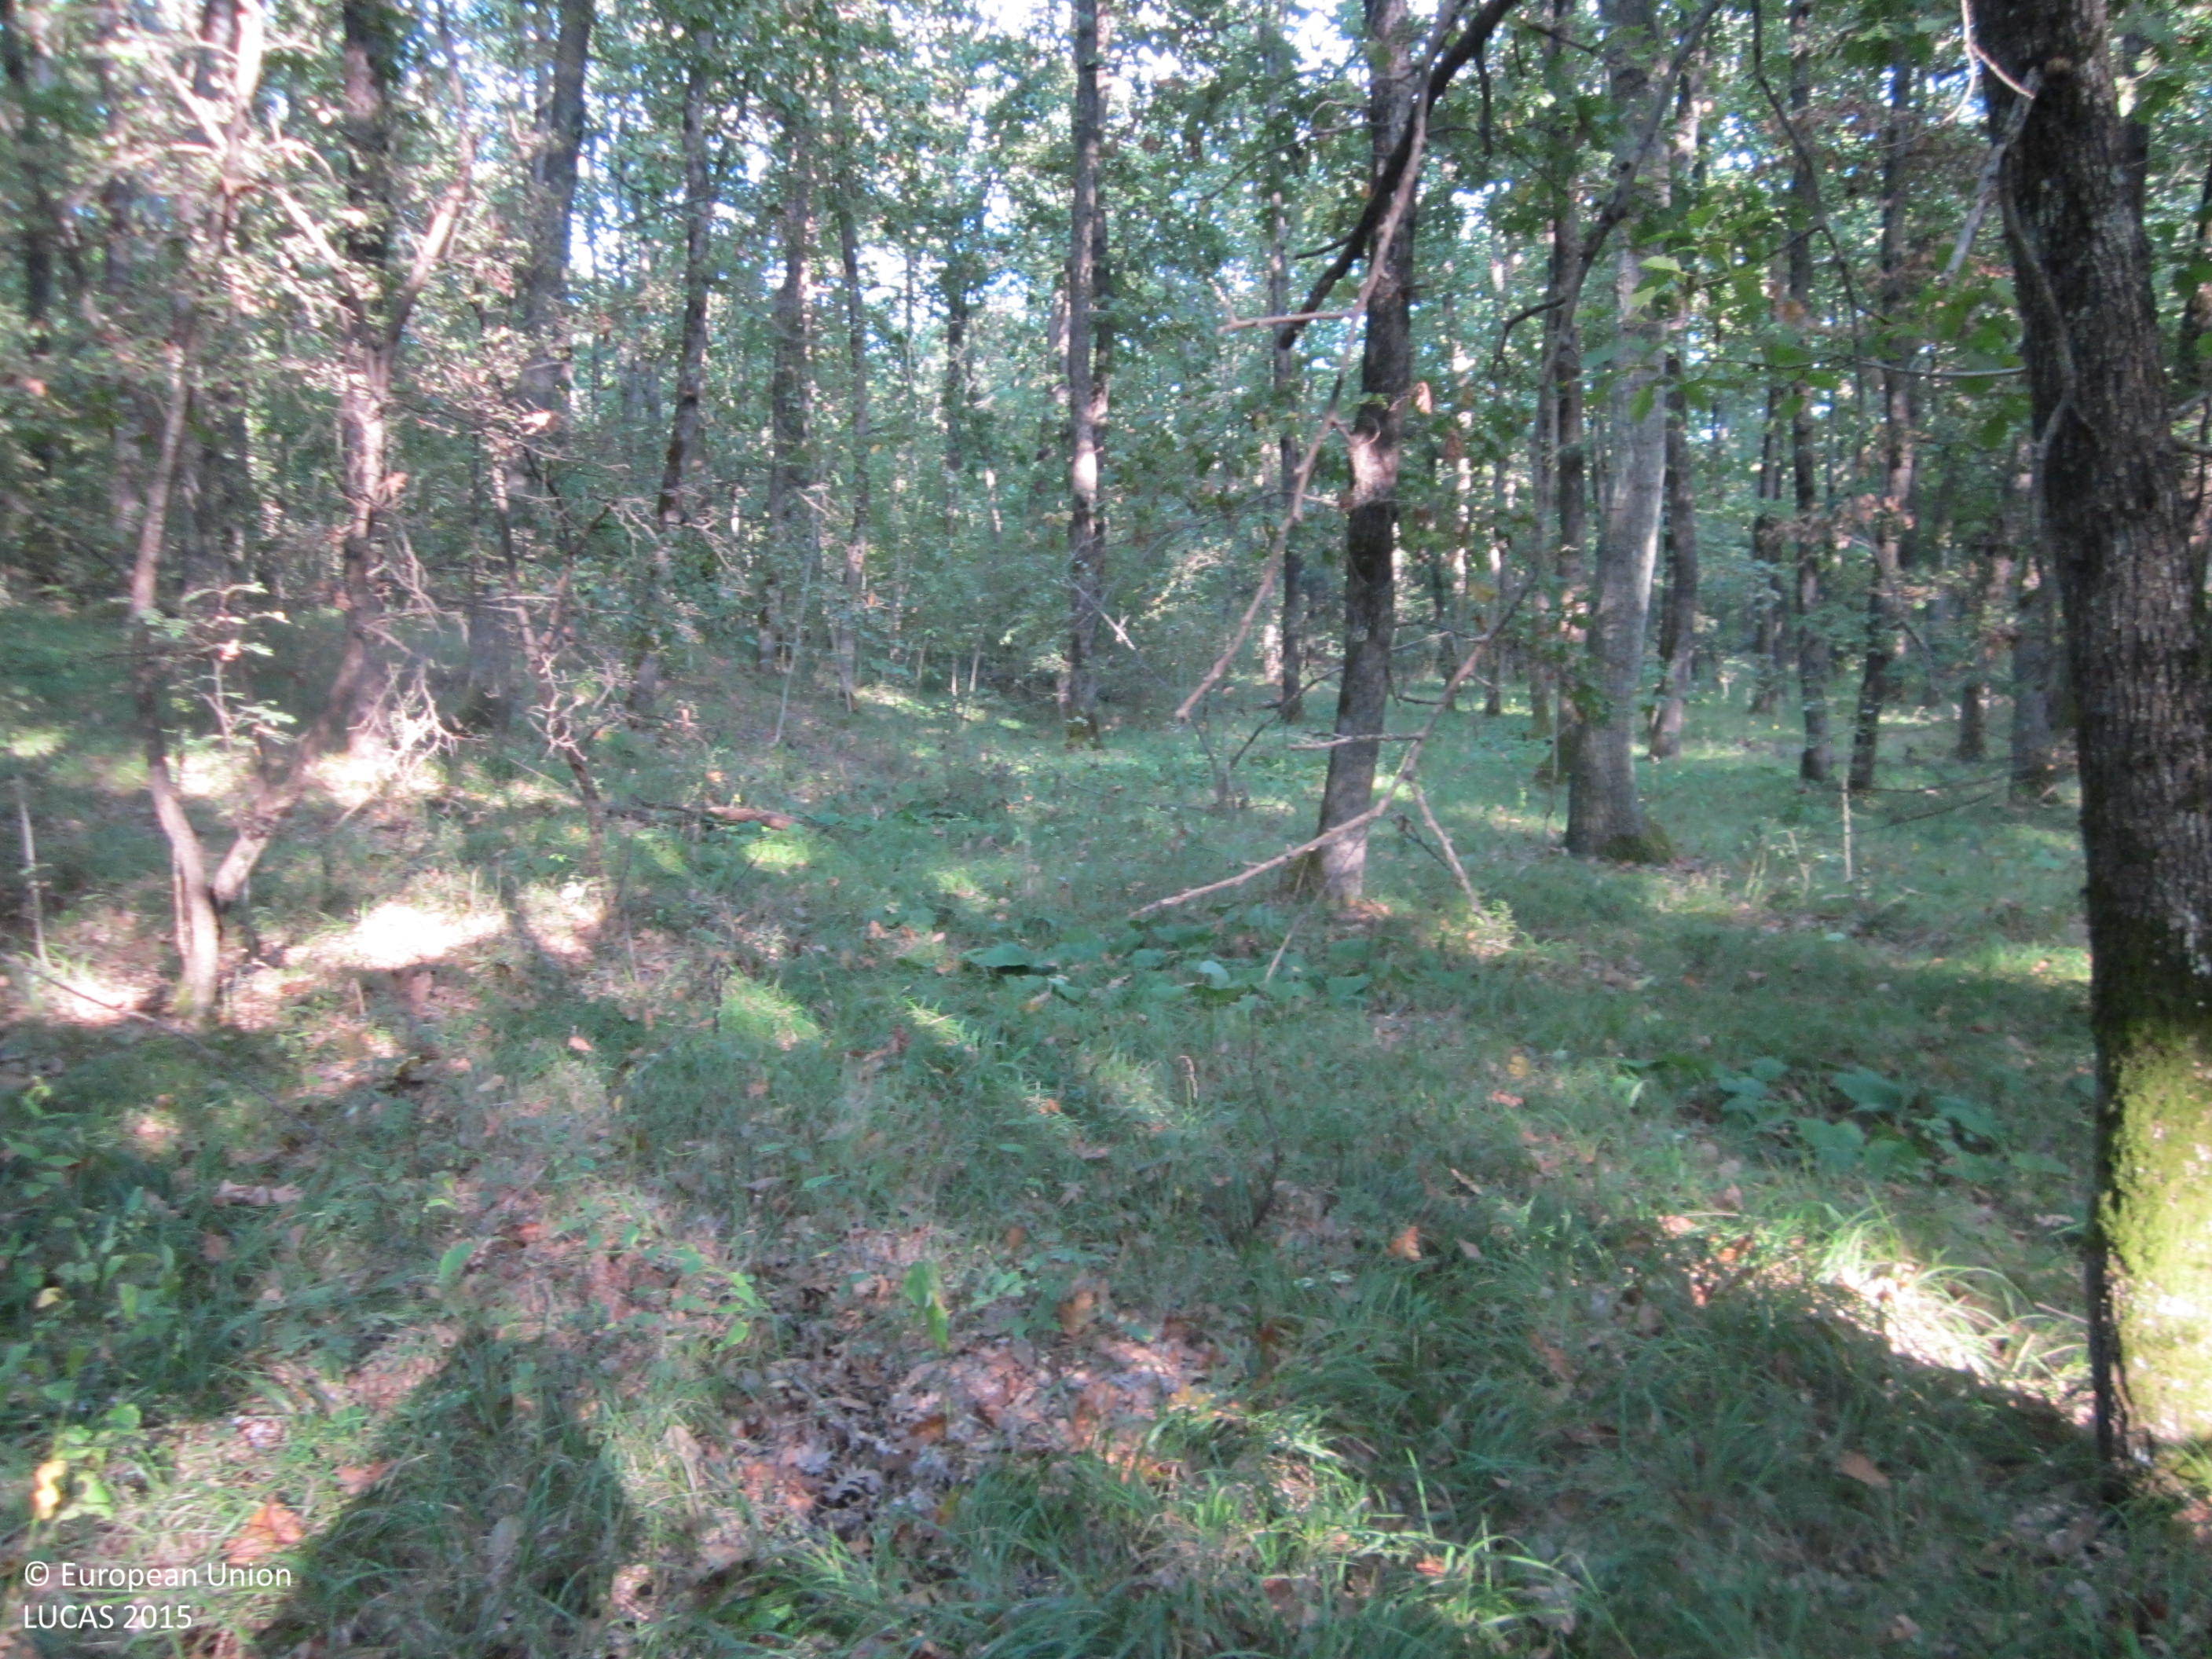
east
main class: Woodland
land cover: Broadleaved woodland
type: thermophilous deciduous forest
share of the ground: > 75 %
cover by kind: broadleaved forest trees 80 %, herbaceous plants 15 %, shrubs 5 %
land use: Forestry
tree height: > 5 m
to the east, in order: Broadleaved woodland; Tracks; Broadleaved woodland; Rivers and streams; Broadleaved woodland; Rivers and streams; Broadleaved woodland; Tracks; Broadleaved woodland
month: September
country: BG
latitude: 42.1934
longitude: 27.6647
